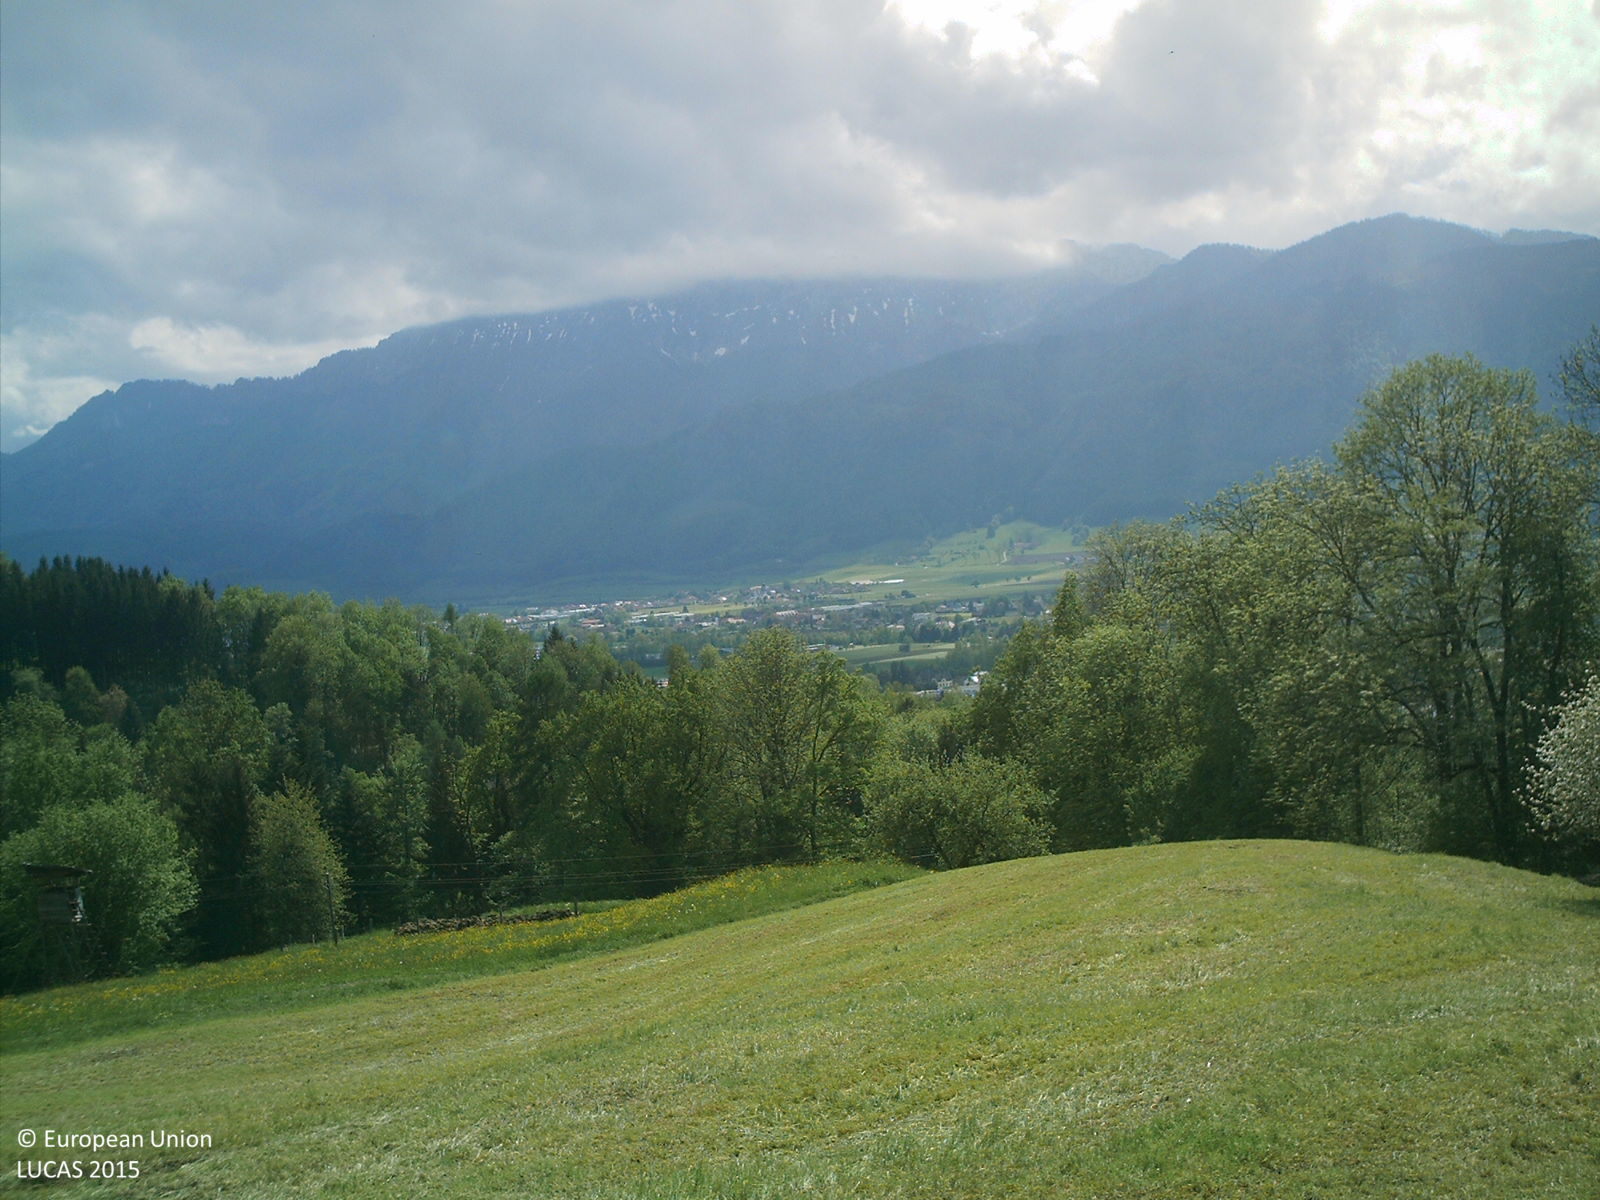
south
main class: Grassland
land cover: Grassland without tree/shrub cover
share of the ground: > 75 %
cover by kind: herbaceous plants 100 %
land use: Agriculture (excluding fallow land and kitchen gardens)
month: May
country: AT
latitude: 47.9118
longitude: 14.1338
